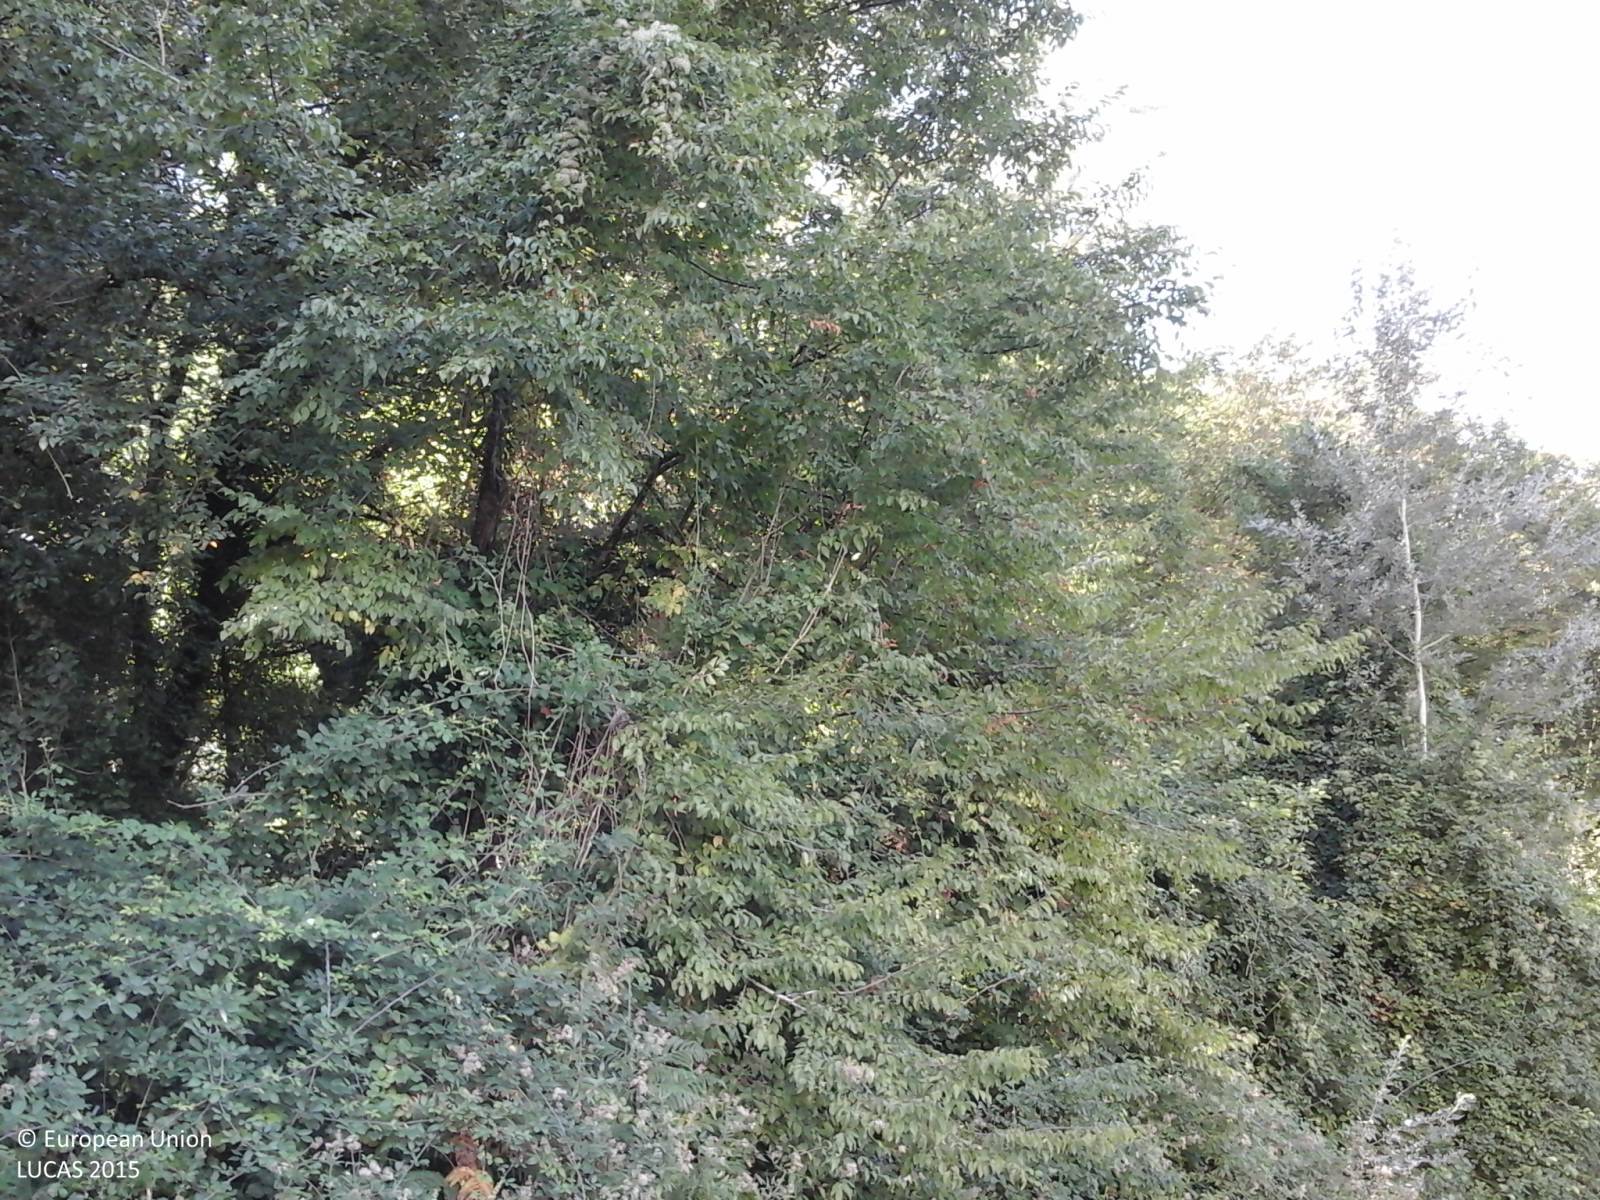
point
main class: Woodland
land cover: Broadleaved woodland
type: thermophilous deciduous forest
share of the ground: > 75 %
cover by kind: broadleaved forest trees 100 %
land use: Semi-natural and natural areas not in use
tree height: > 5 m
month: September
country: IT
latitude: 42.3502
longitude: 12.5770
